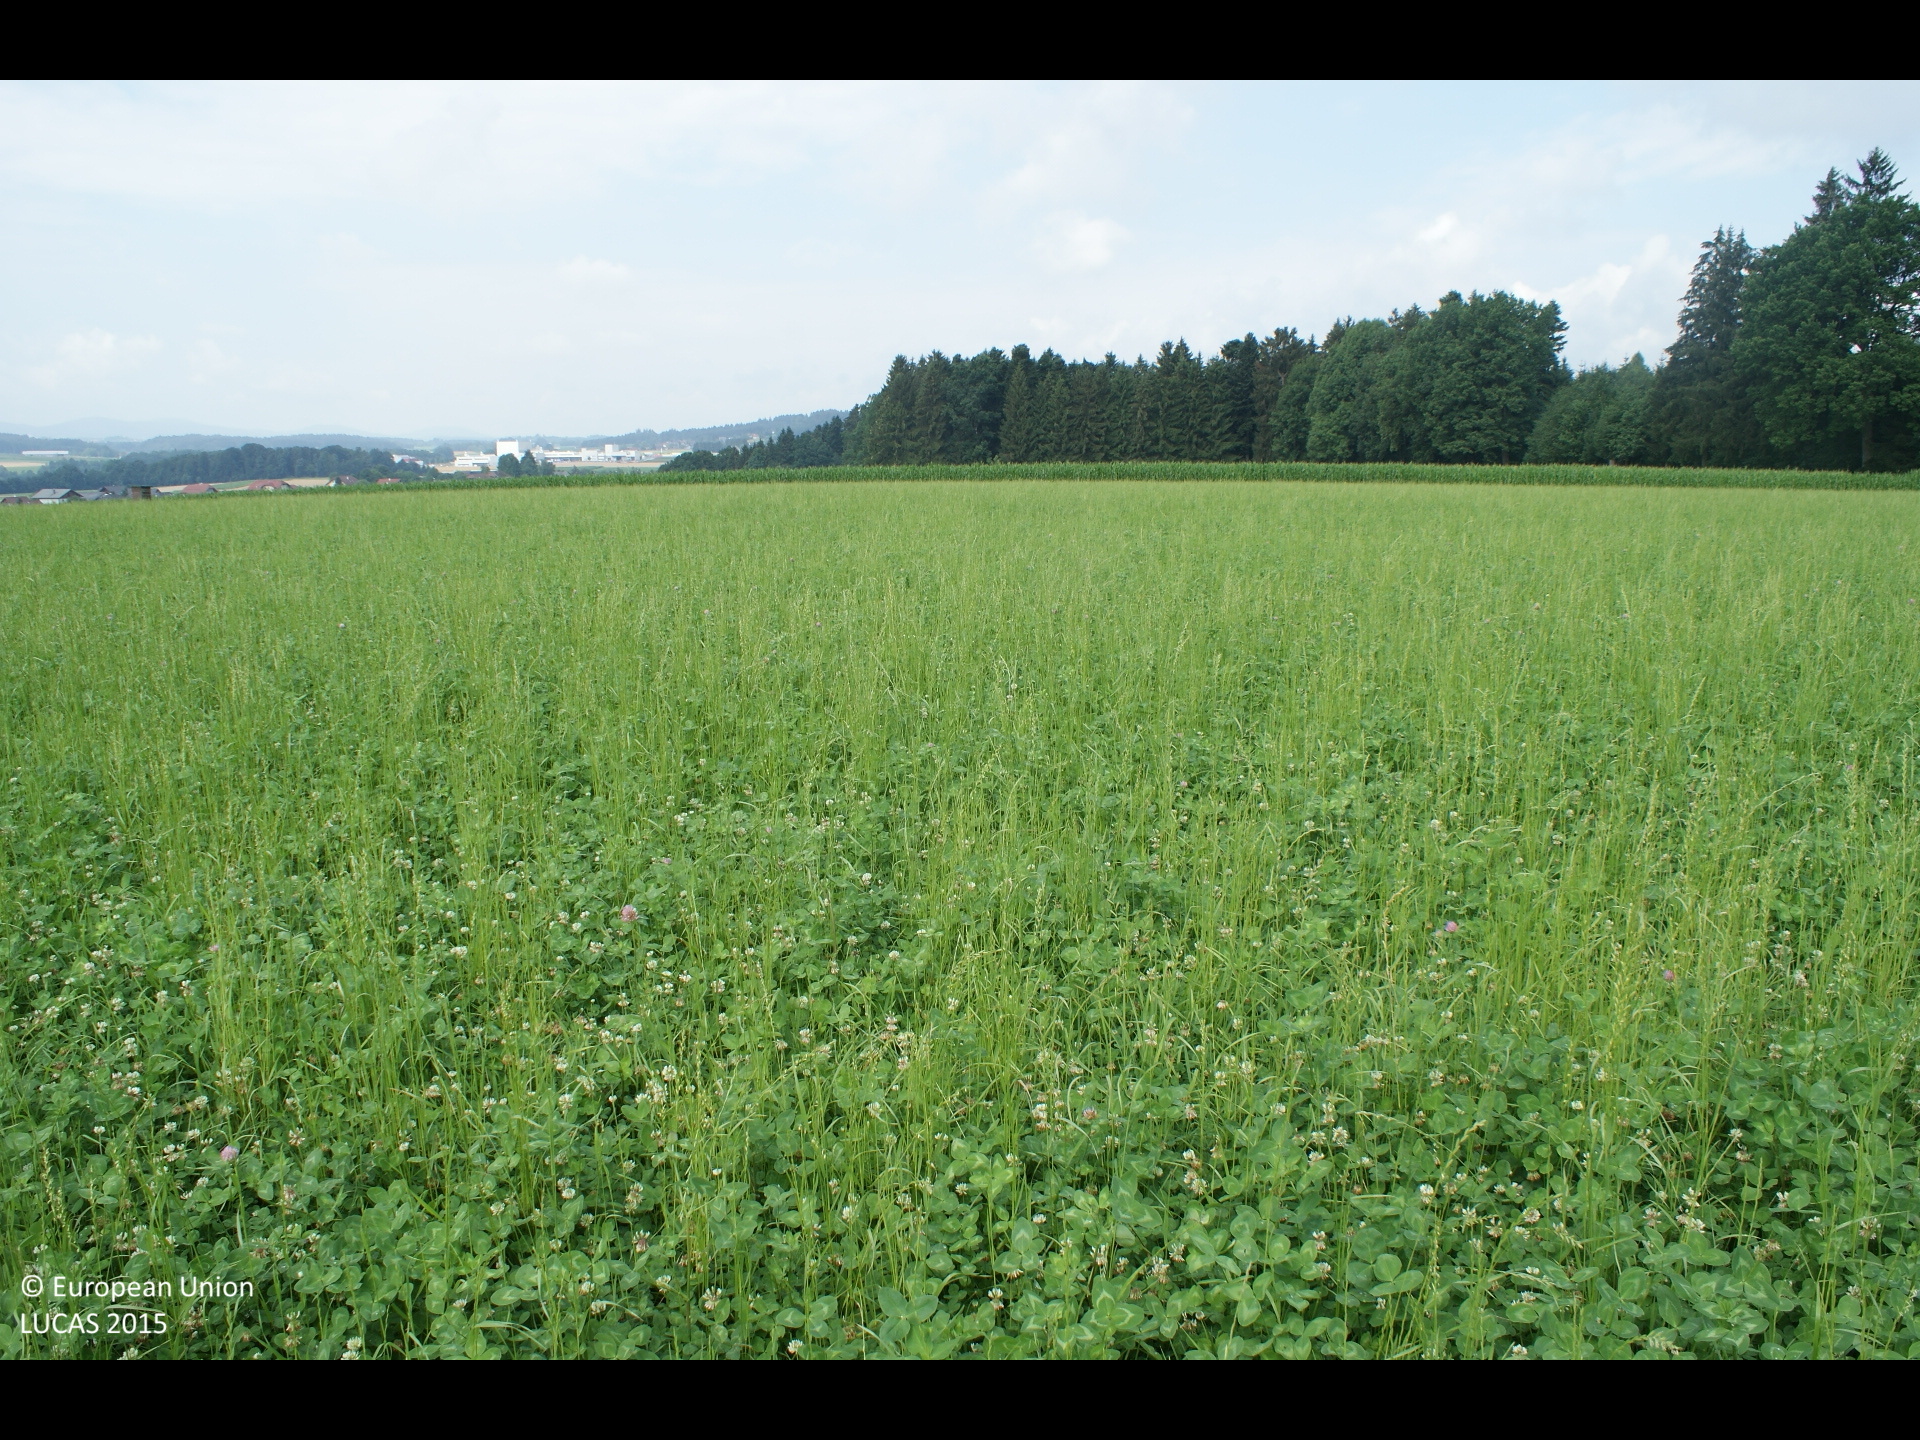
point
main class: Cropland
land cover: Temporary grasslands
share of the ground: > 75 %
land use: Agriculture (excluding fallow land and kitchen gardens)
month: July
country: AT
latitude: 48.0034
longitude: 13.5778
